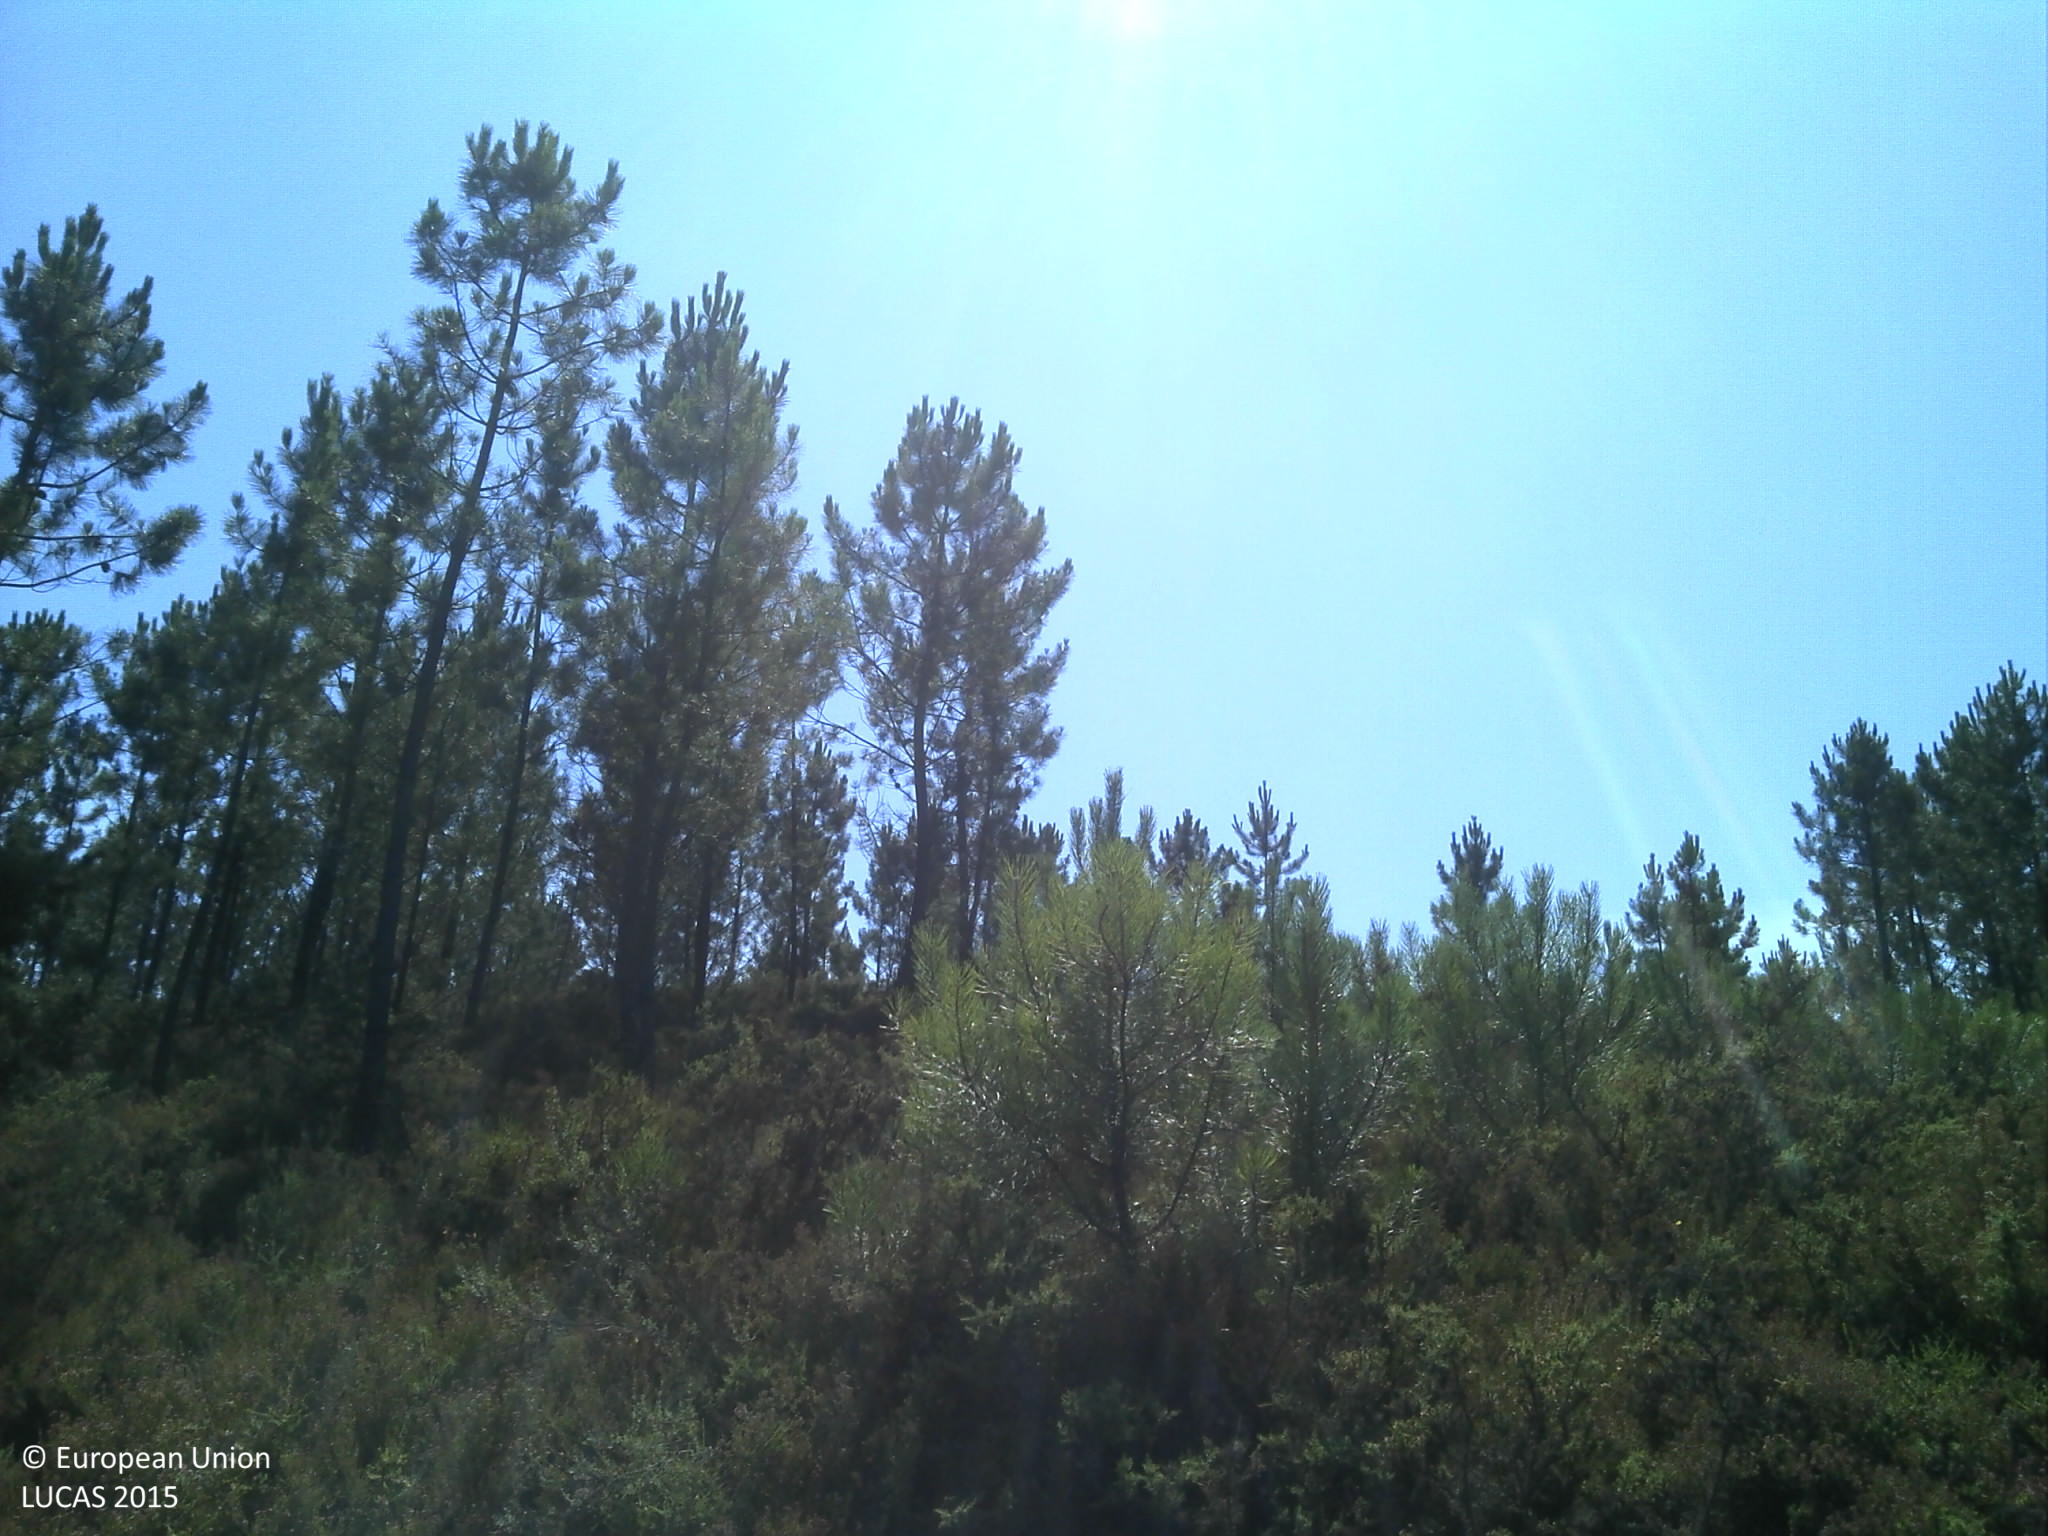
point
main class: Woodland
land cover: Pine dominated coniferous woodland
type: coniferous forest of the mediterranean region
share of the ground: 50 - 75 %
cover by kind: coniferous forest trees 50 %, shrubs 40 %, unconsolidated bare surface 10 %
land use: Forestry
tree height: > 5 m
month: July
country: PT
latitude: 40.2463
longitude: -8.2172
